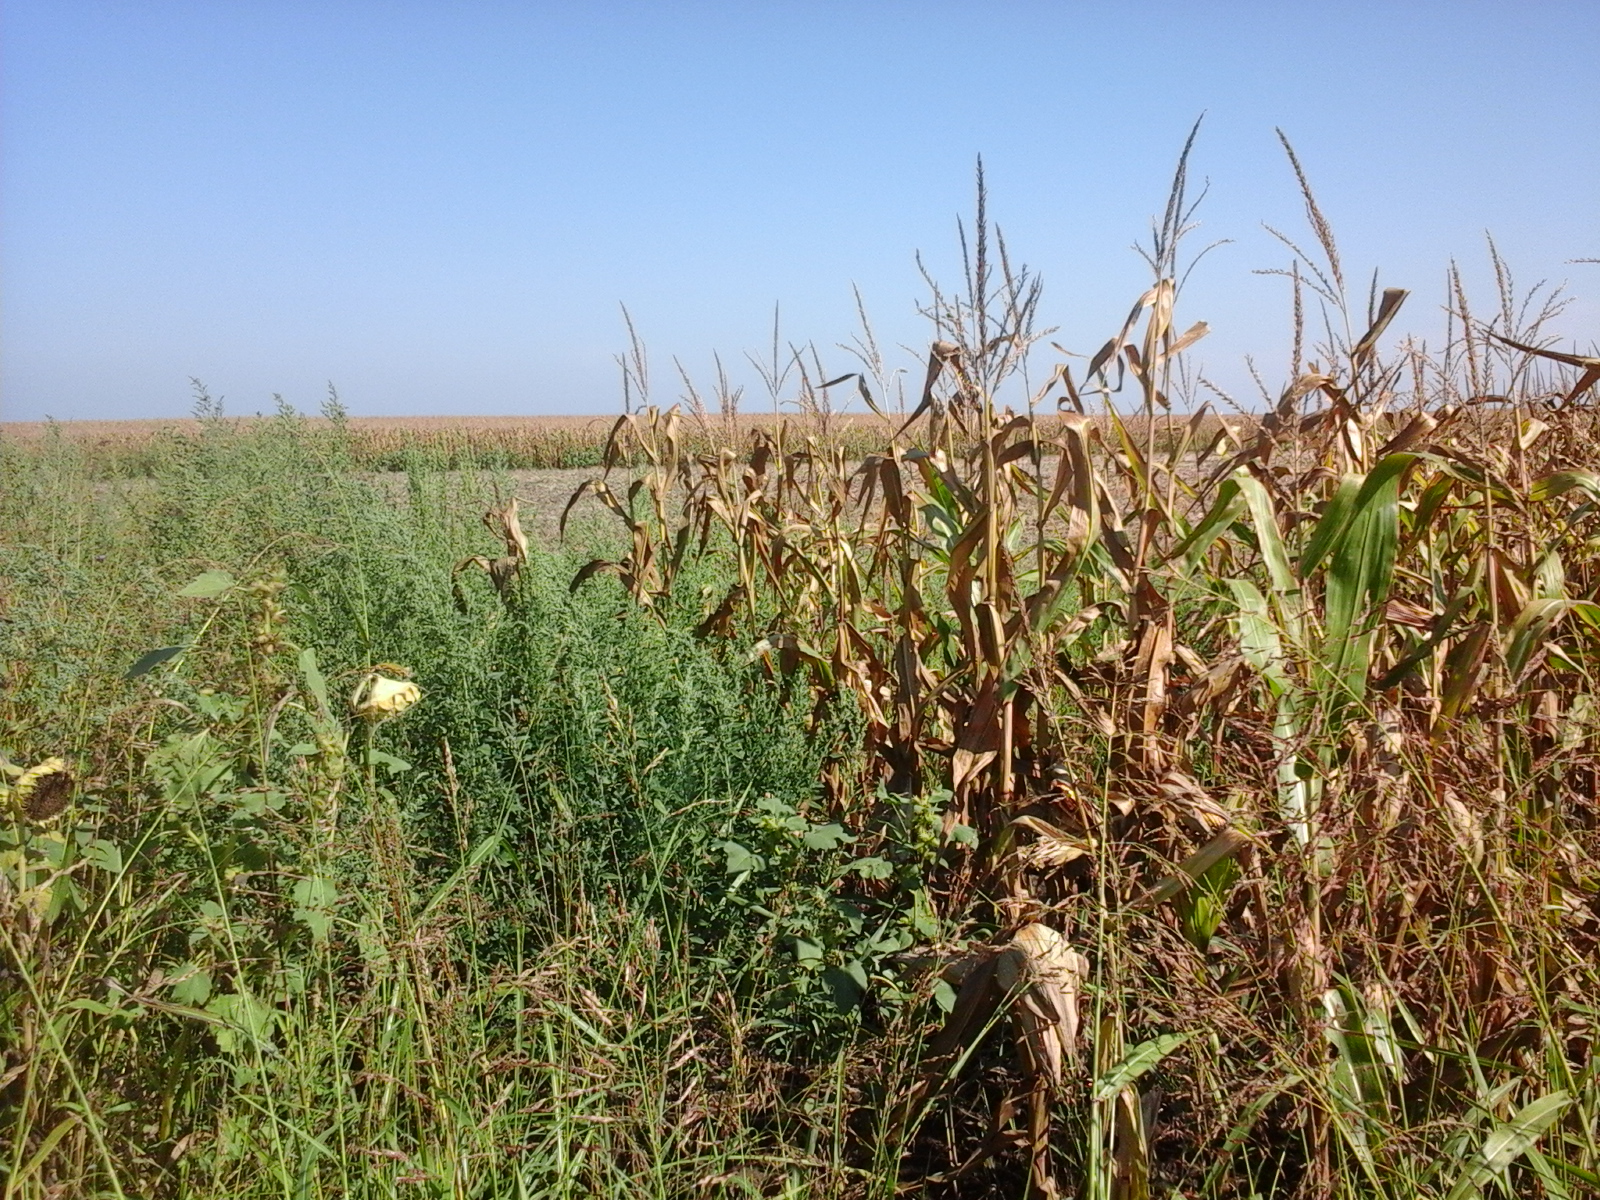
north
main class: Cropland
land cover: Sunflower
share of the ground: > 75 %
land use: Agriculture (excluding fallow land and kitchen gardens)
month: August
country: RO
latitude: 46.0721
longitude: 21.0067
